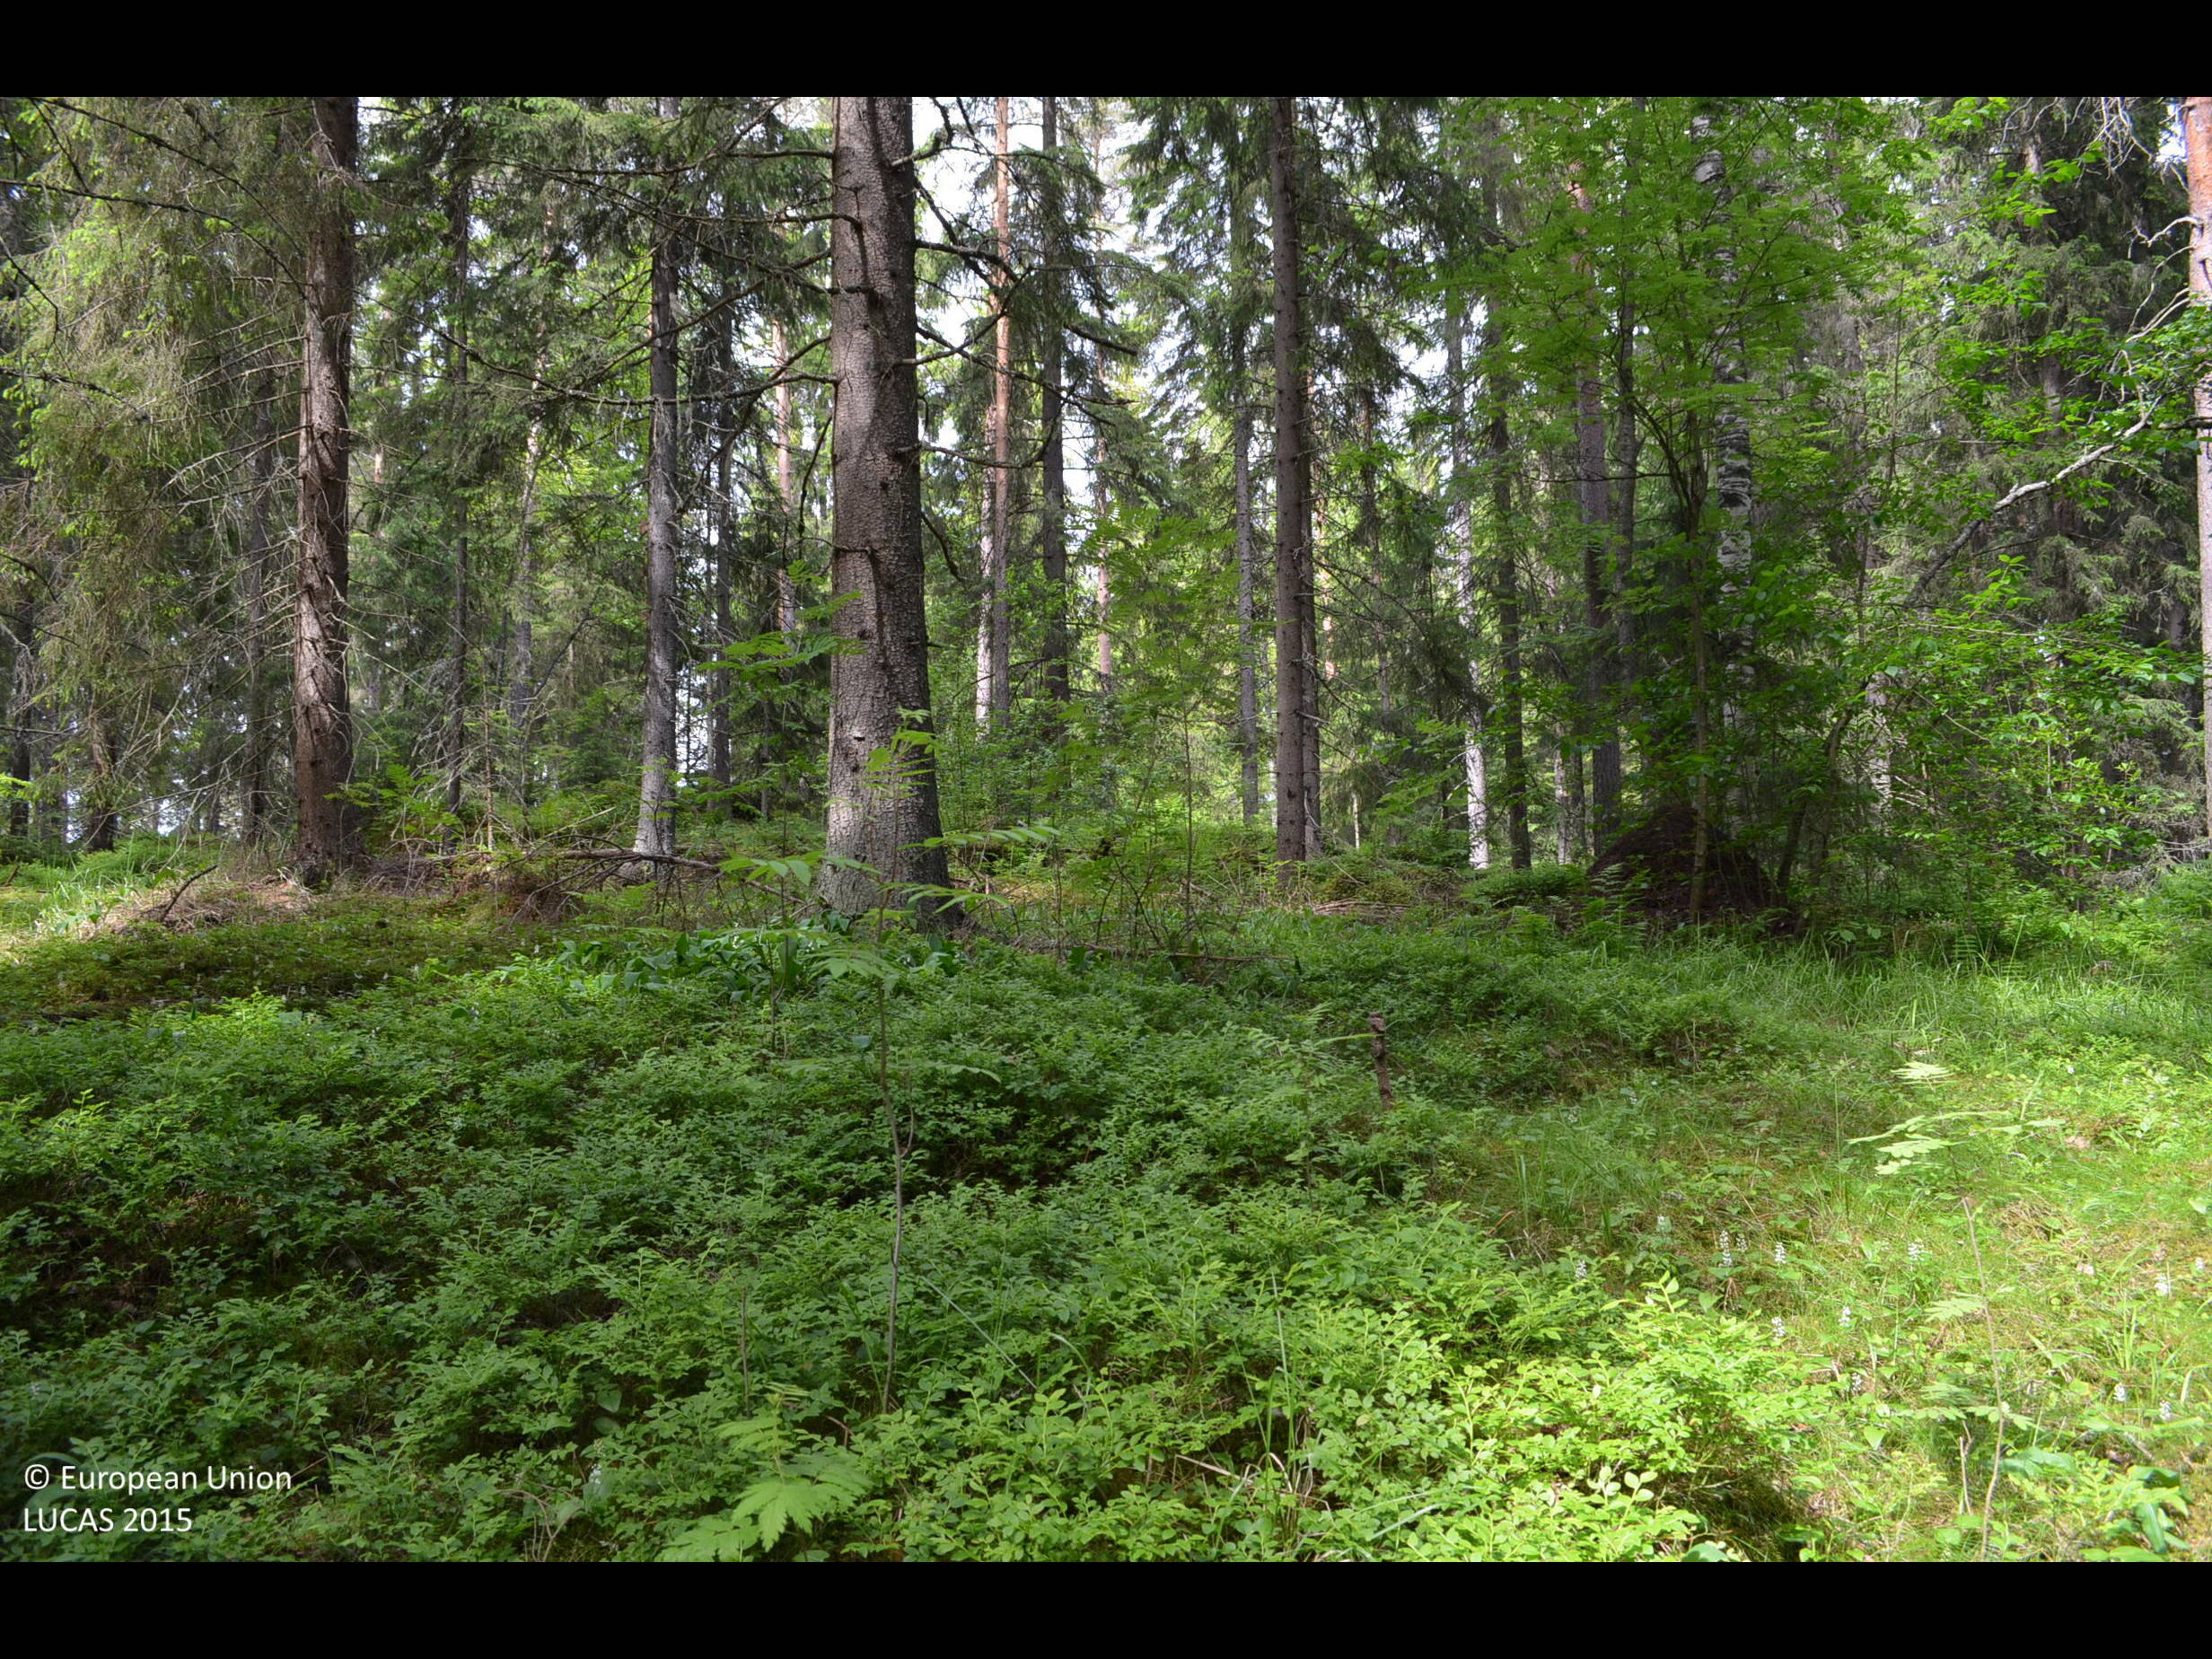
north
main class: Woodland
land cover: Other coniferous woodland
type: boreal forest
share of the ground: > 75 %
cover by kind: coniferous forest trees 80 %, shrubs 10 %, broadleaved forest trees 5 %, herbaceous plants 5 %
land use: Forestry
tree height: > 5 m
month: June
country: FI
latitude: 61.7818
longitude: 23.2875
